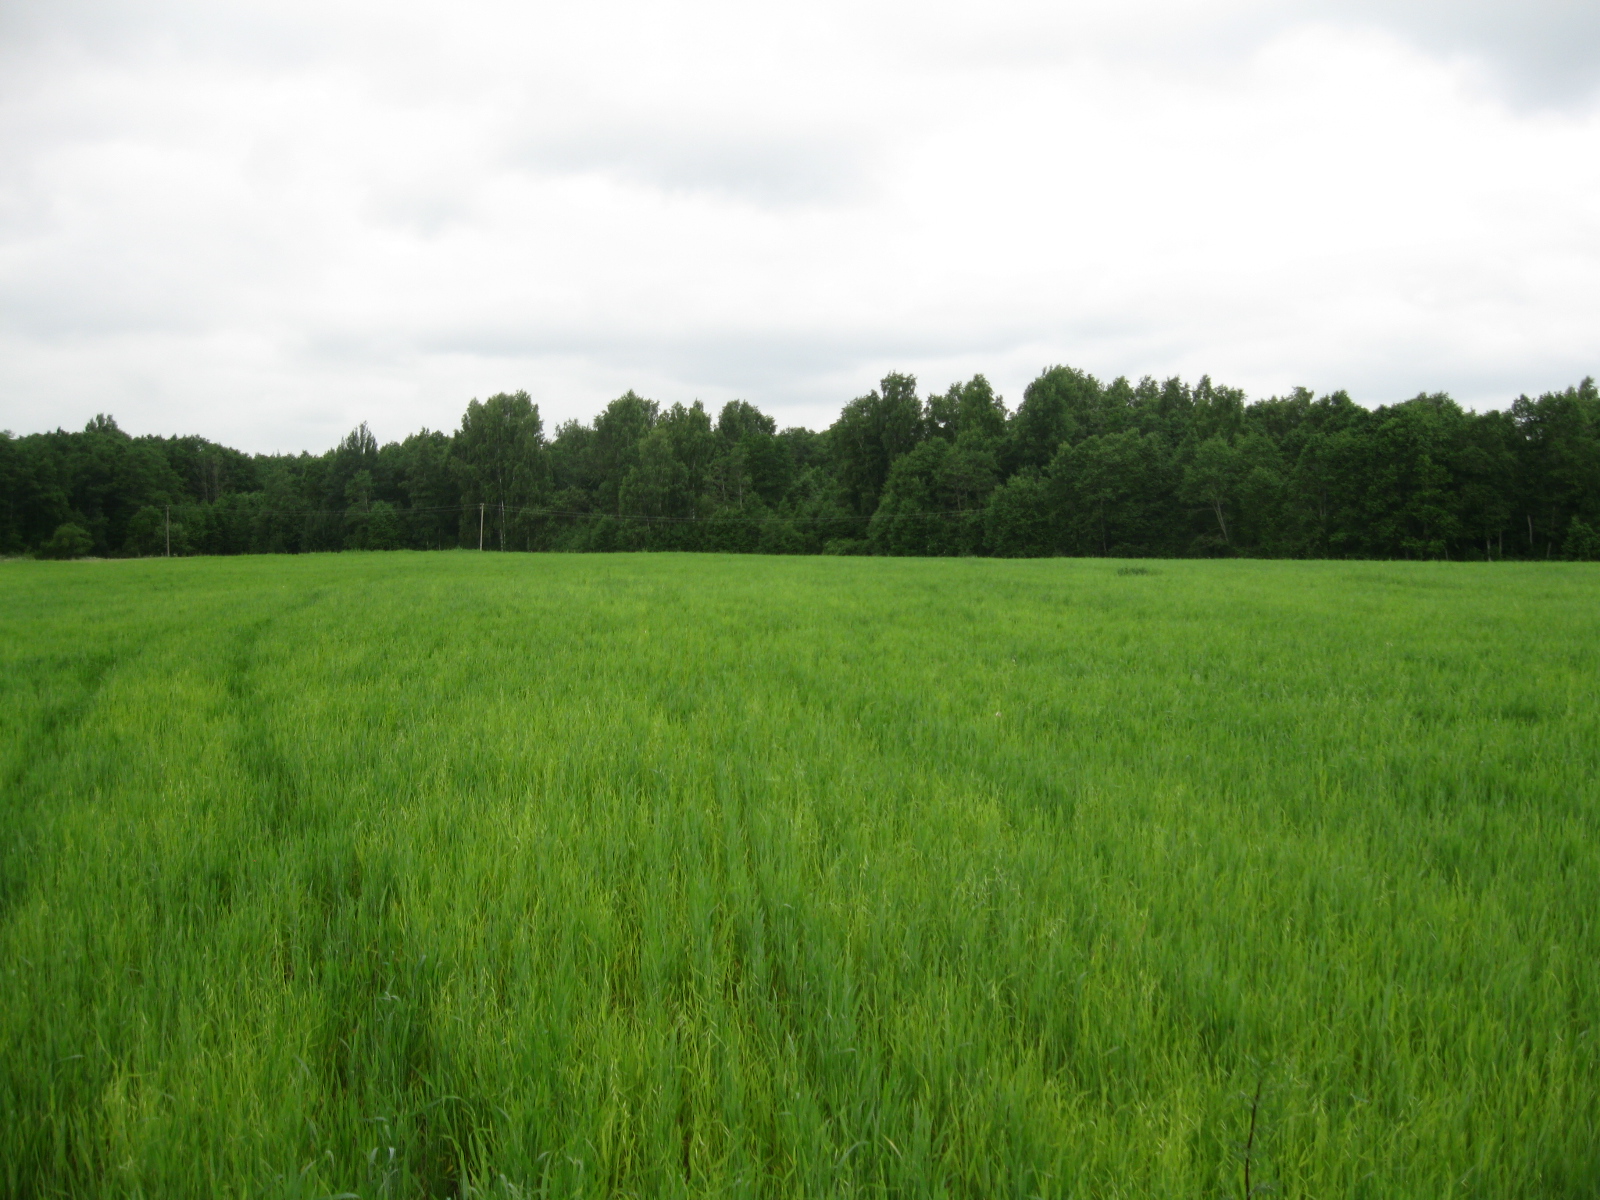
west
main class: Cropland
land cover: Mixed cereals for fodder
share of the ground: > 75 %
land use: Agriculture (excluding fallow land and kitchen gardens)
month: June
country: LT
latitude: 56.1811
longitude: 24.9783
